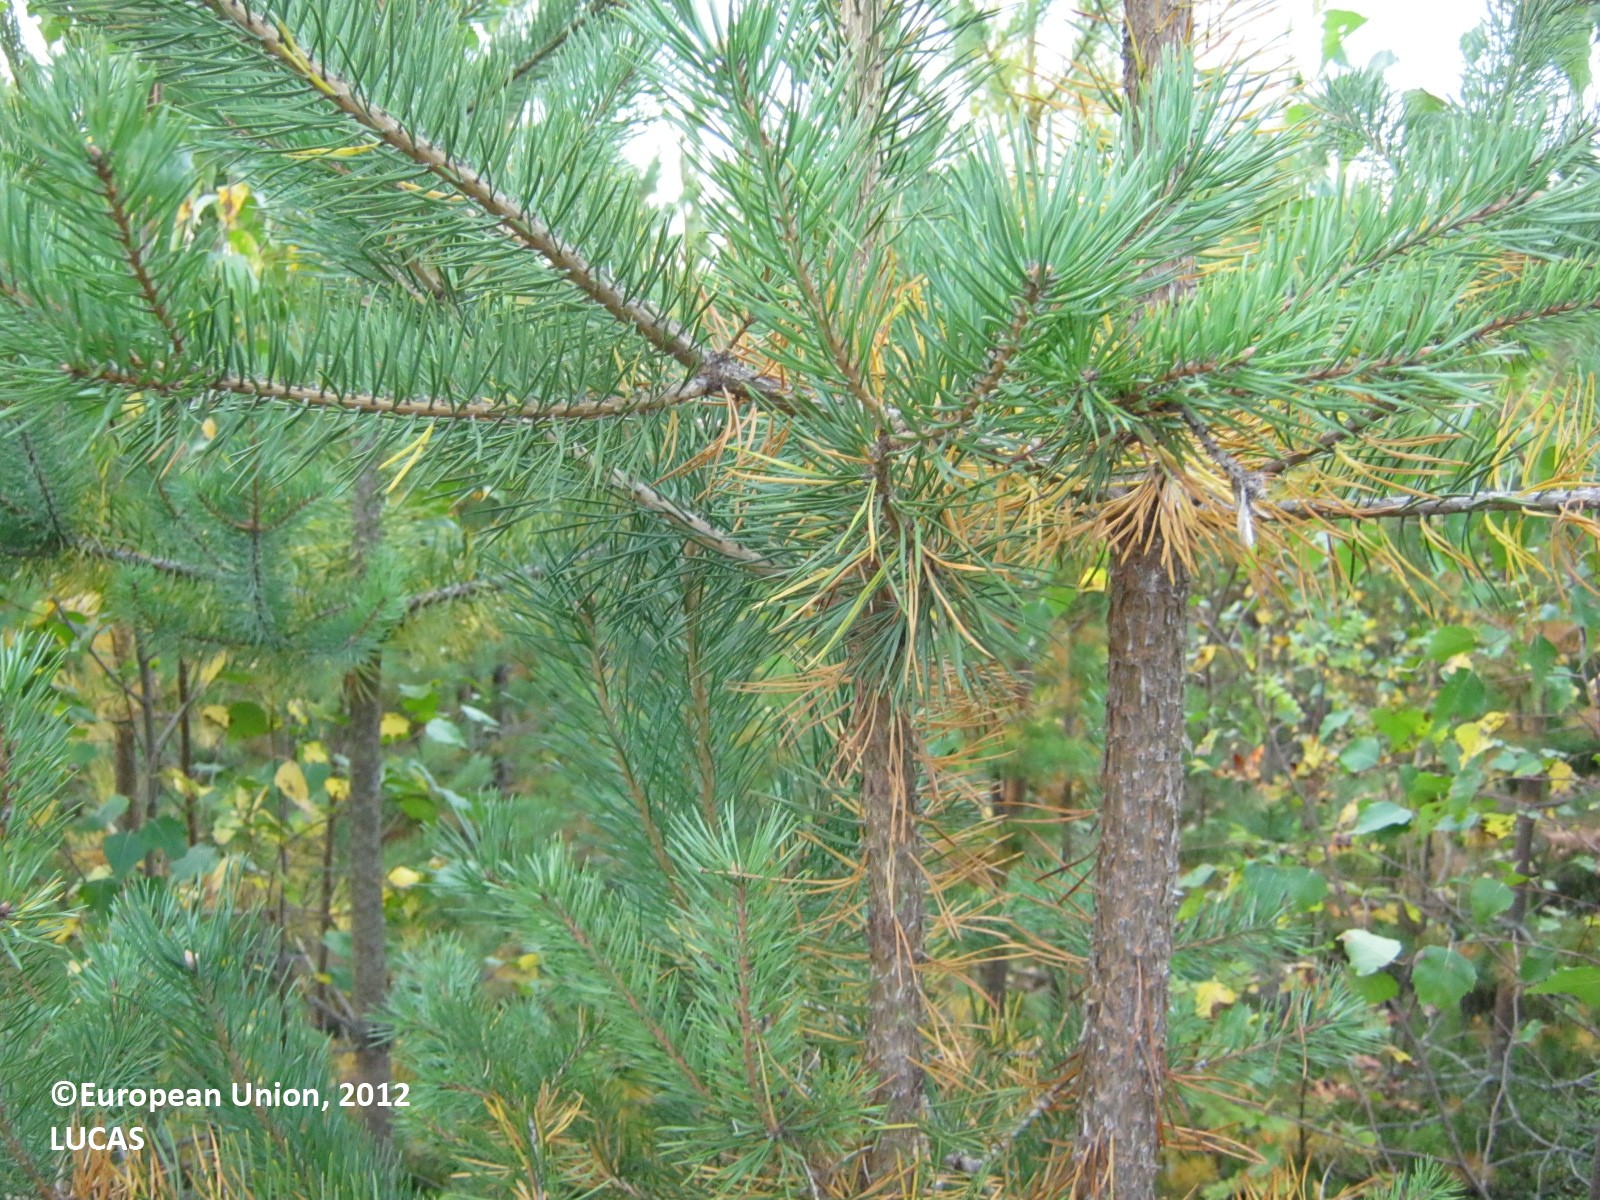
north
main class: Woodland
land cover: Pine dominated coniferous woodland
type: boreal forest
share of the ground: > 75 %
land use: Forestry
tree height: < 5 m
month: September
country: FI
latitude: 60.8488
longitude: 27.9583
